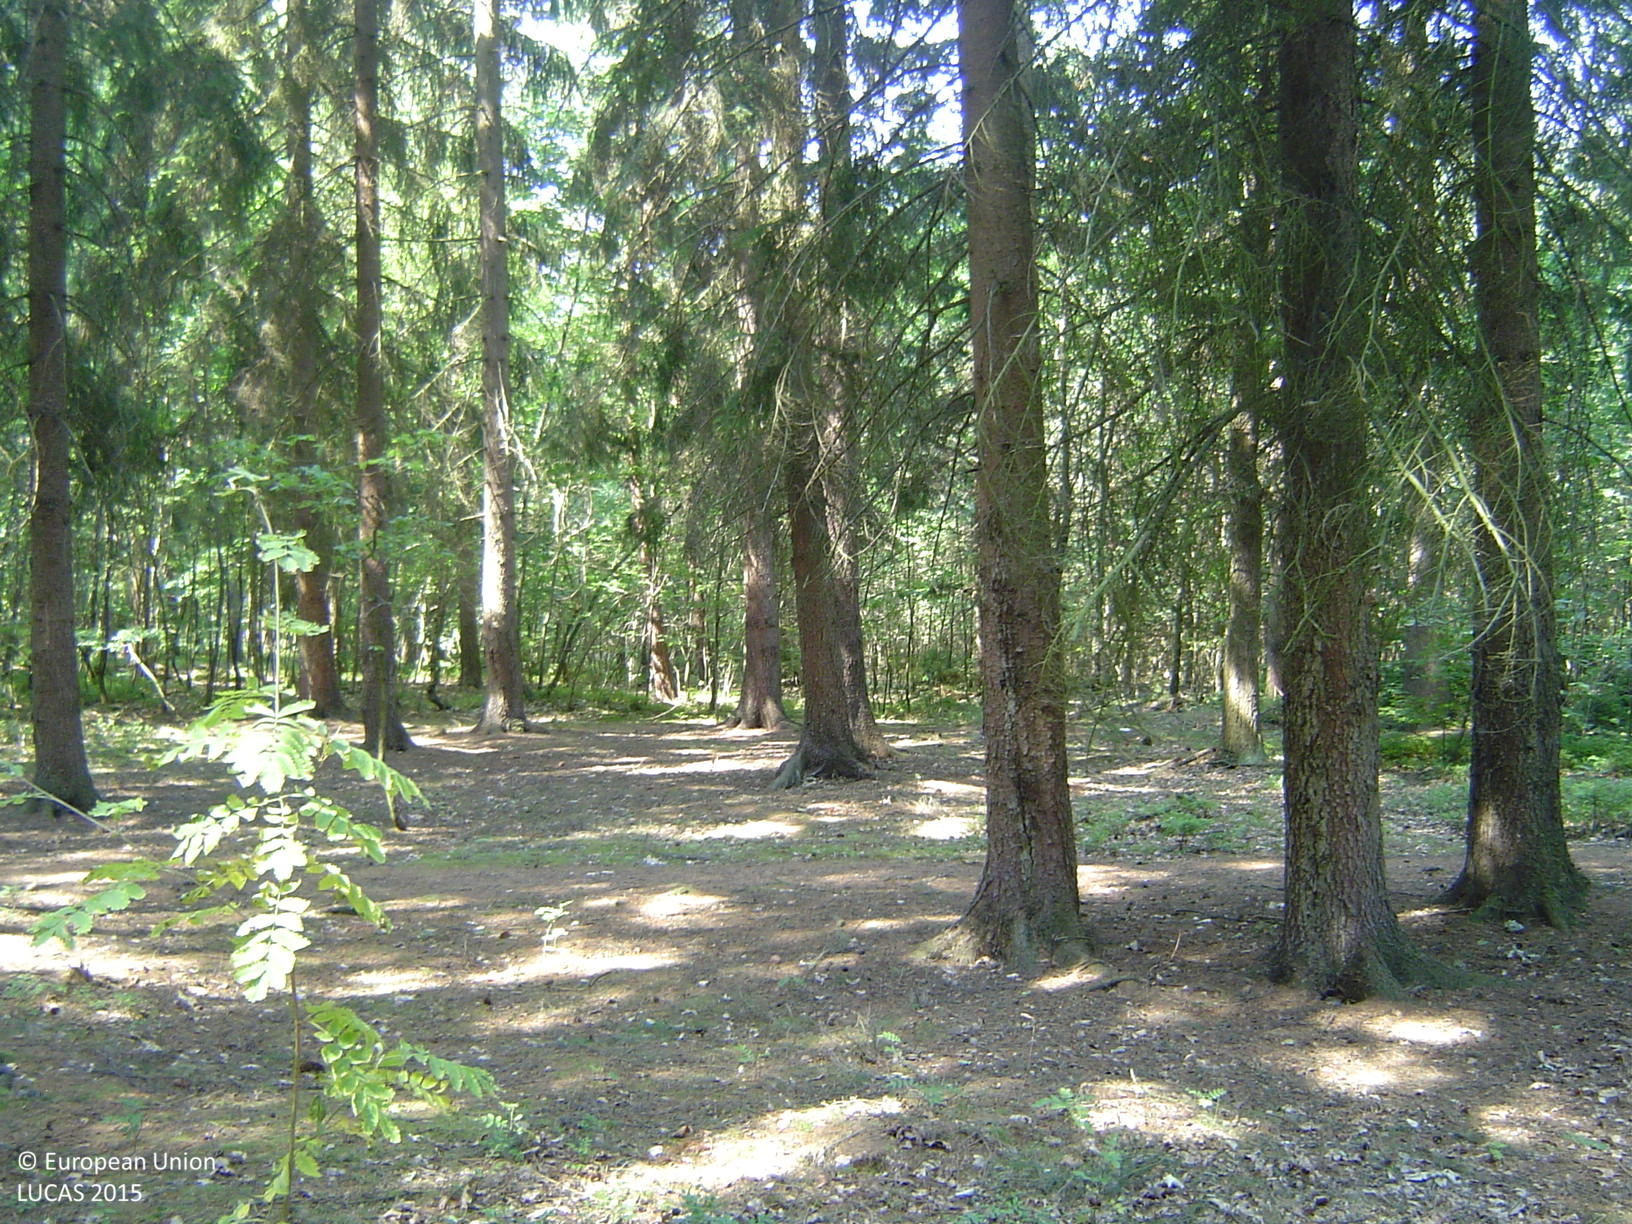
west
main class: Woodland
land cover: Pine dominated mixed woodland
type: hemiboreal forest and nemoral coniferous forest and mixed broadleaved-coniferous forest
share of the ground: > 75 %
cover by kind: coniferous forest trees 70 %, broadleaved forest trees 25 %, herbaceous plants 5 %
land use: Forestry
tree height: > 5 m
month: August
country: CZ
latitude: 50.1732
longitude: 13.8512
